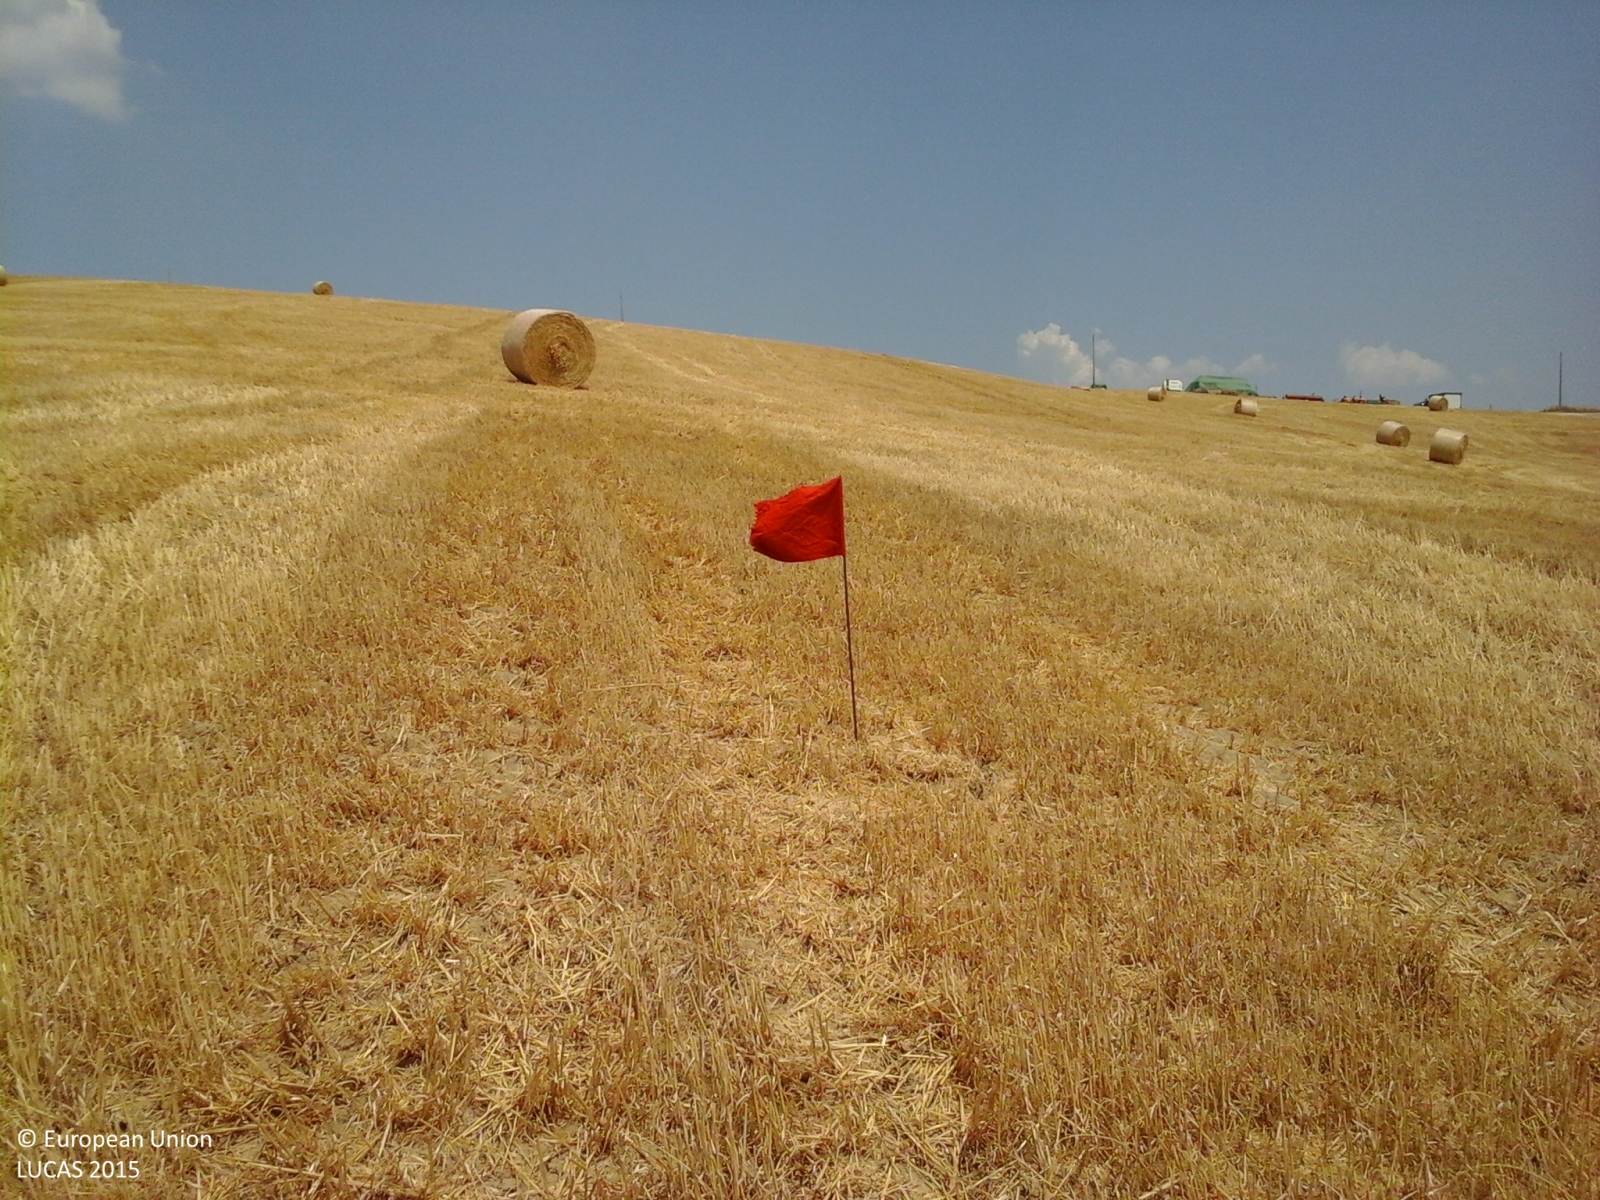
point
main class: Cropland
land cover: Durum wheat
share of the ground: > 75 %
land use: Agriculture (excluding fallow land and kitchen gardens)
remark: Harvested field
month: July
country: IT
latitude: 43.1105
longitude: 11.6295
